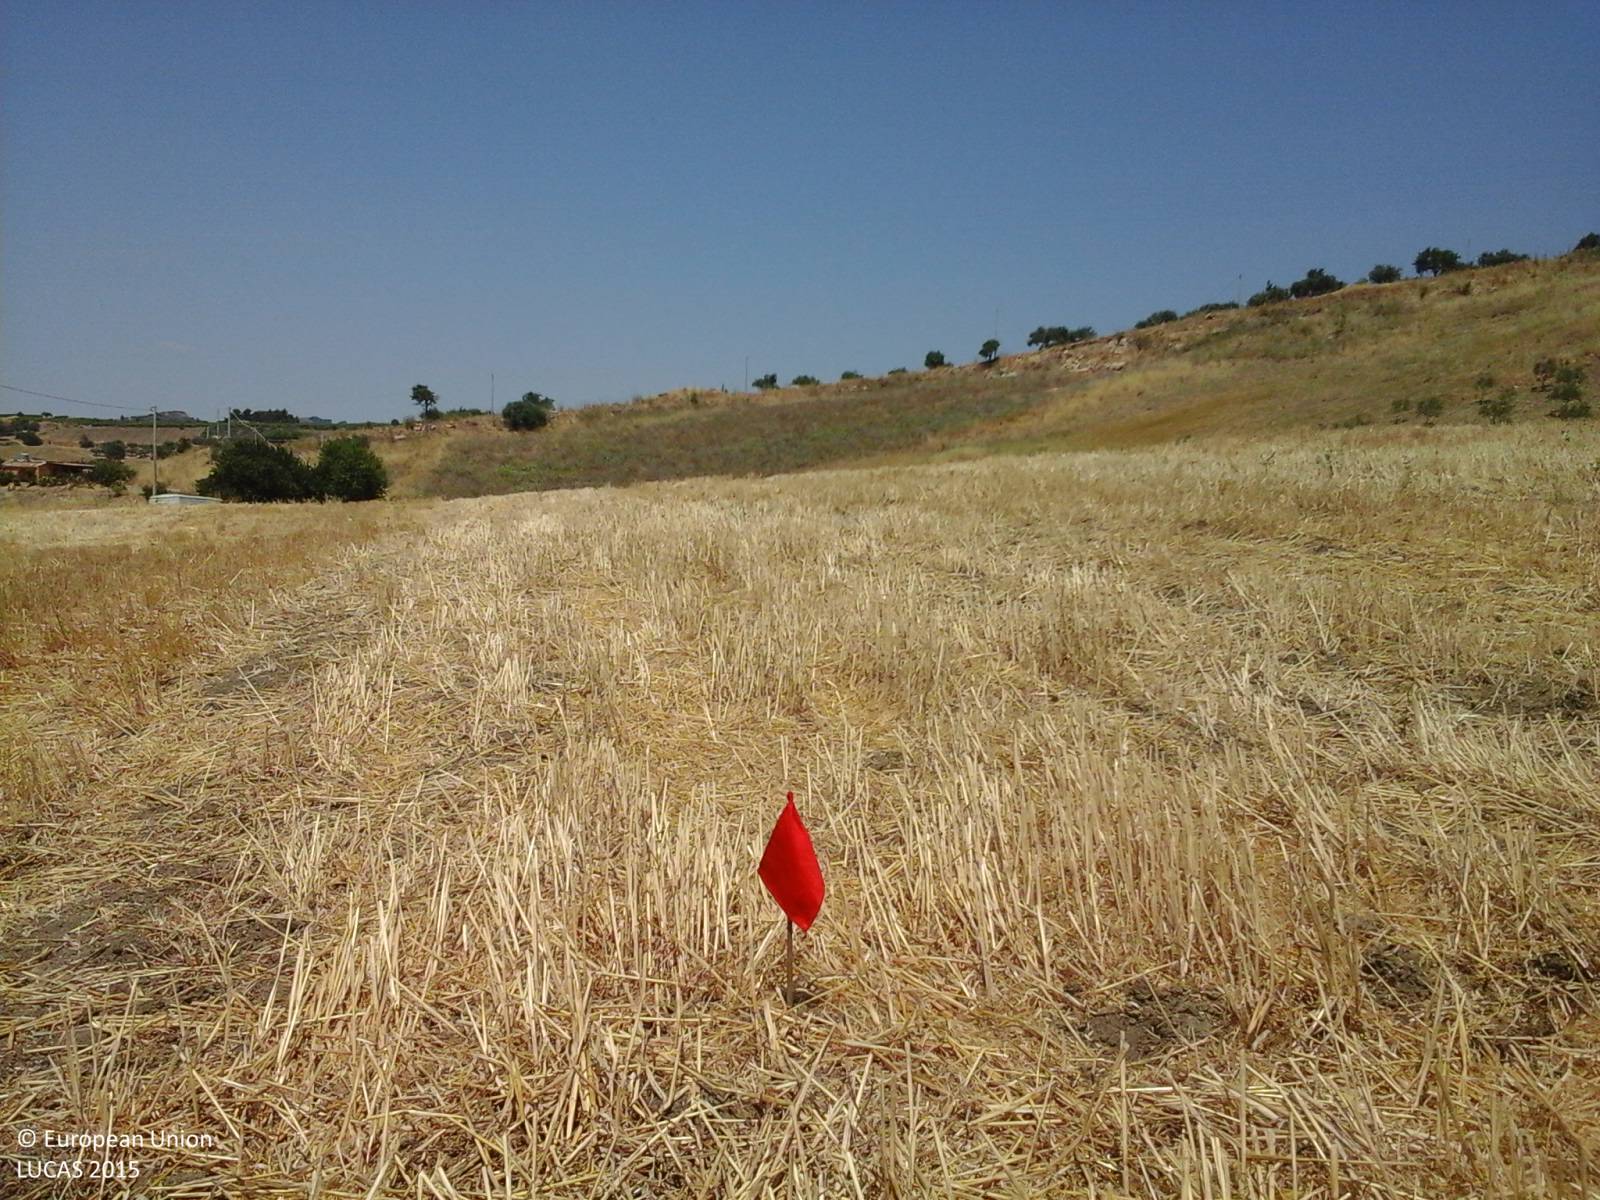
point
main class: Cropland
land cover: Durum wheat
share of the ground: > 75 %
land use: Agriculture (excluding fallow land and kitchen gardens)
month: July
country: IT
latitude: 37.7726
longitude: 13.0089
